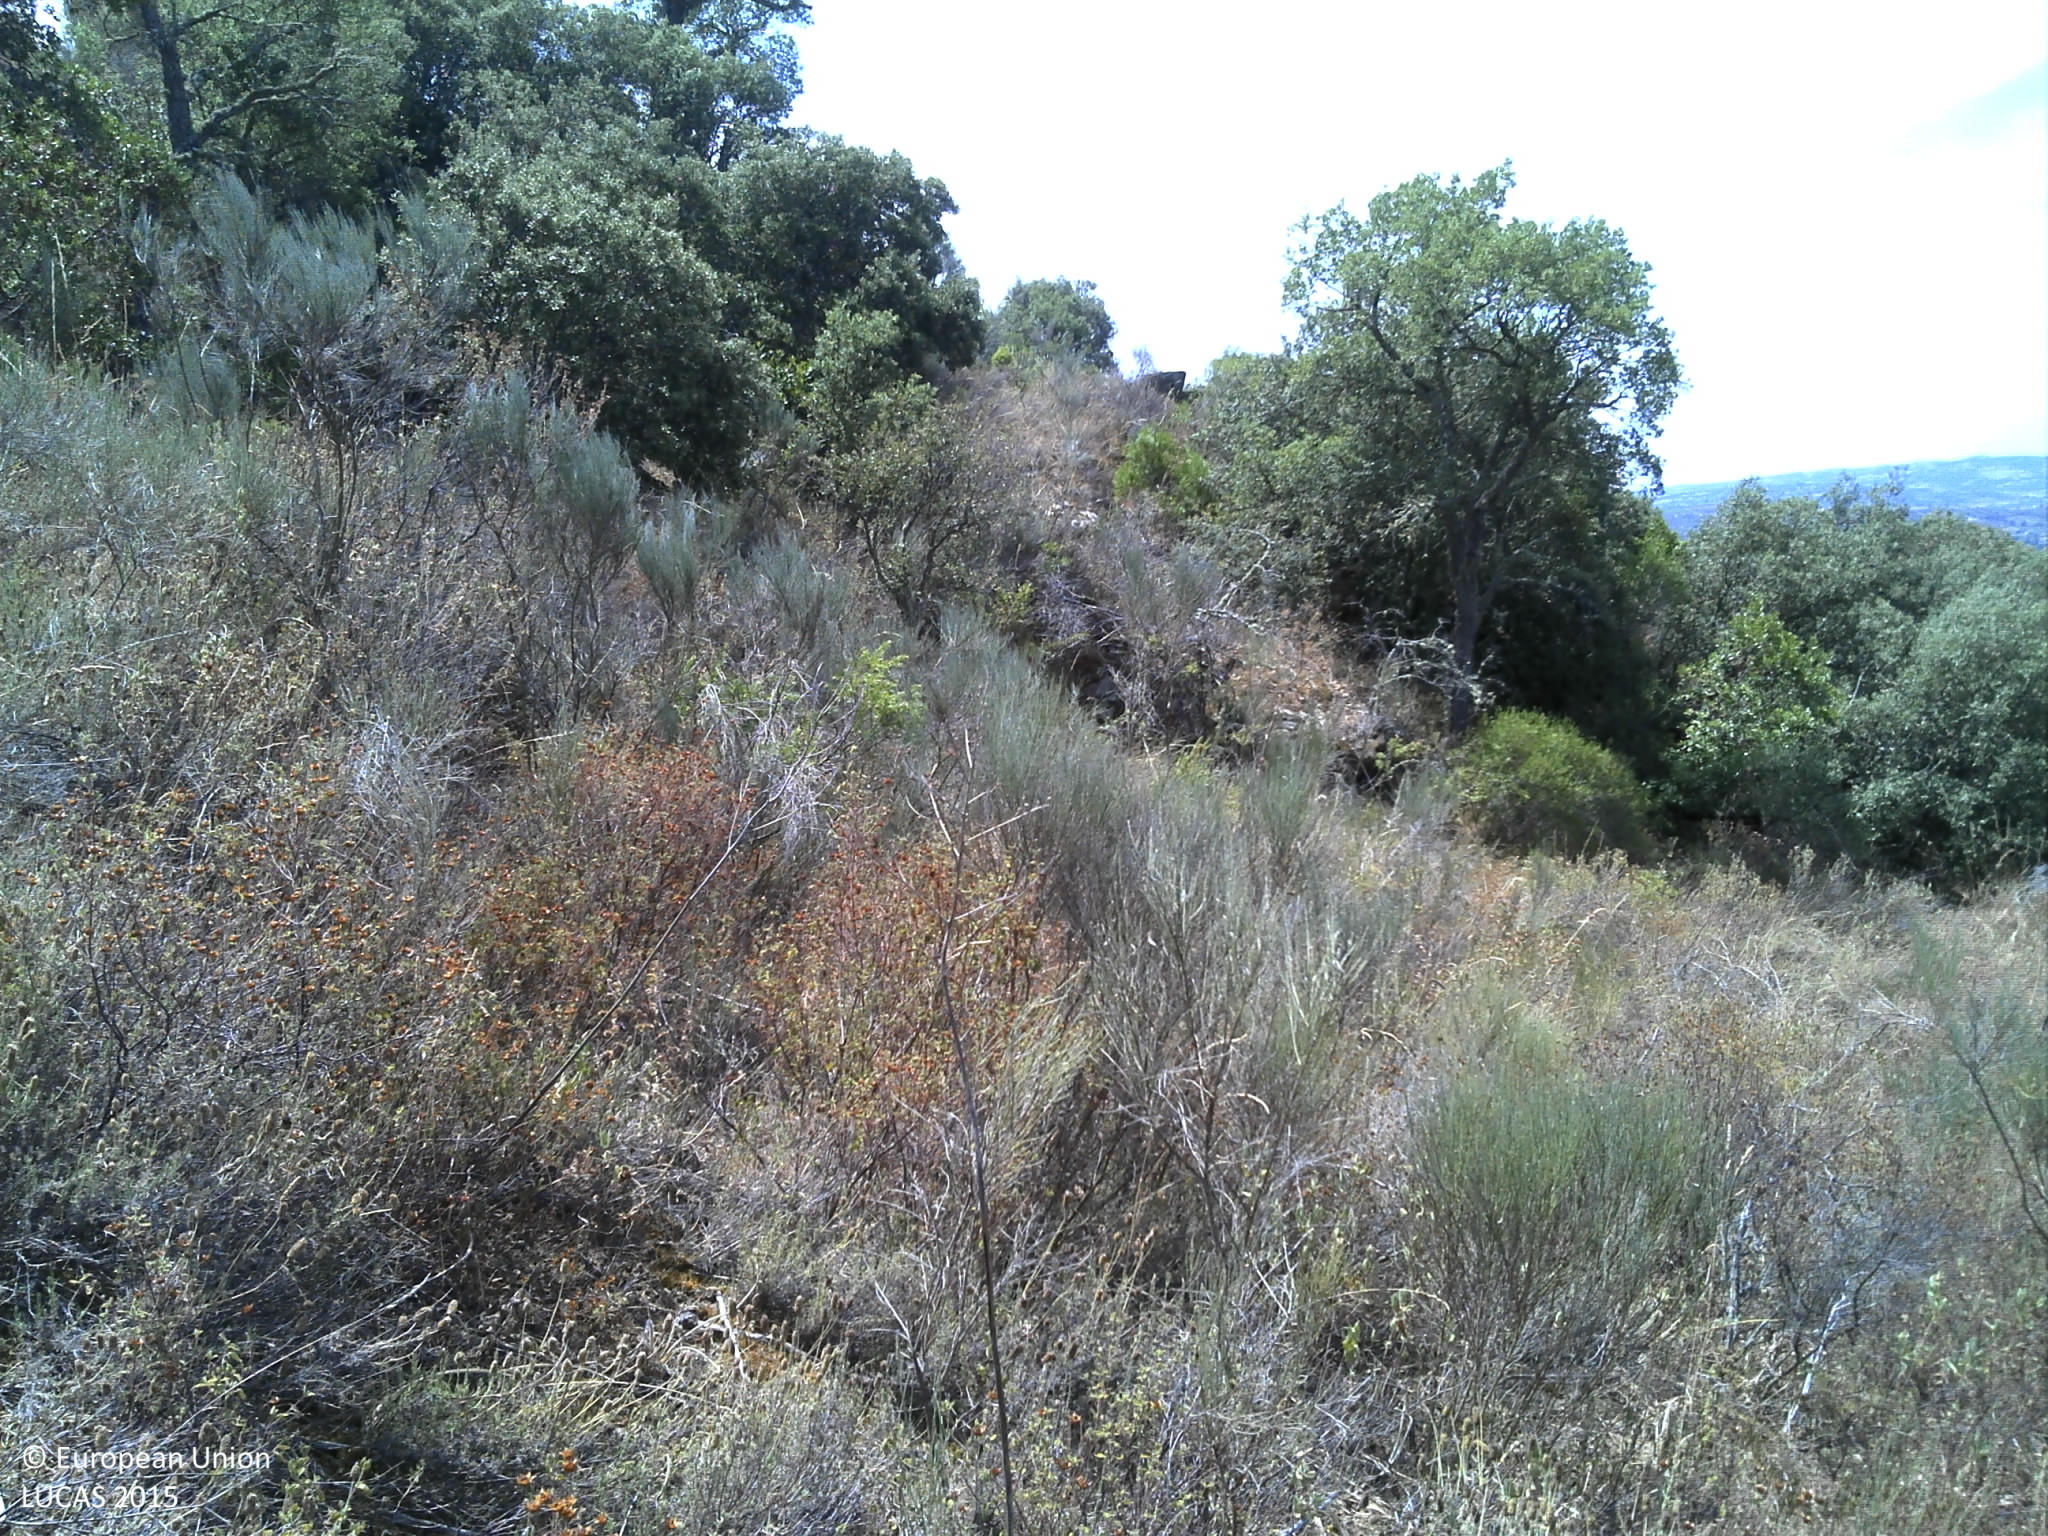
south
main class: Woodland
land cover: Broadleaved woodland
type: broadleaved evergreen forest
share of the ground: 10 - 25 %
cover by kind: shrubs 70 %, broadleaved forest trees 20 %, coniferous forest trees 5 %, unconsolidated bare surface 5 %
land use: Semi-natural and natural areas not in use
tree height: < 5 m
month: July
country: PT
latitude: 41.1284
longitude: -7.3293
